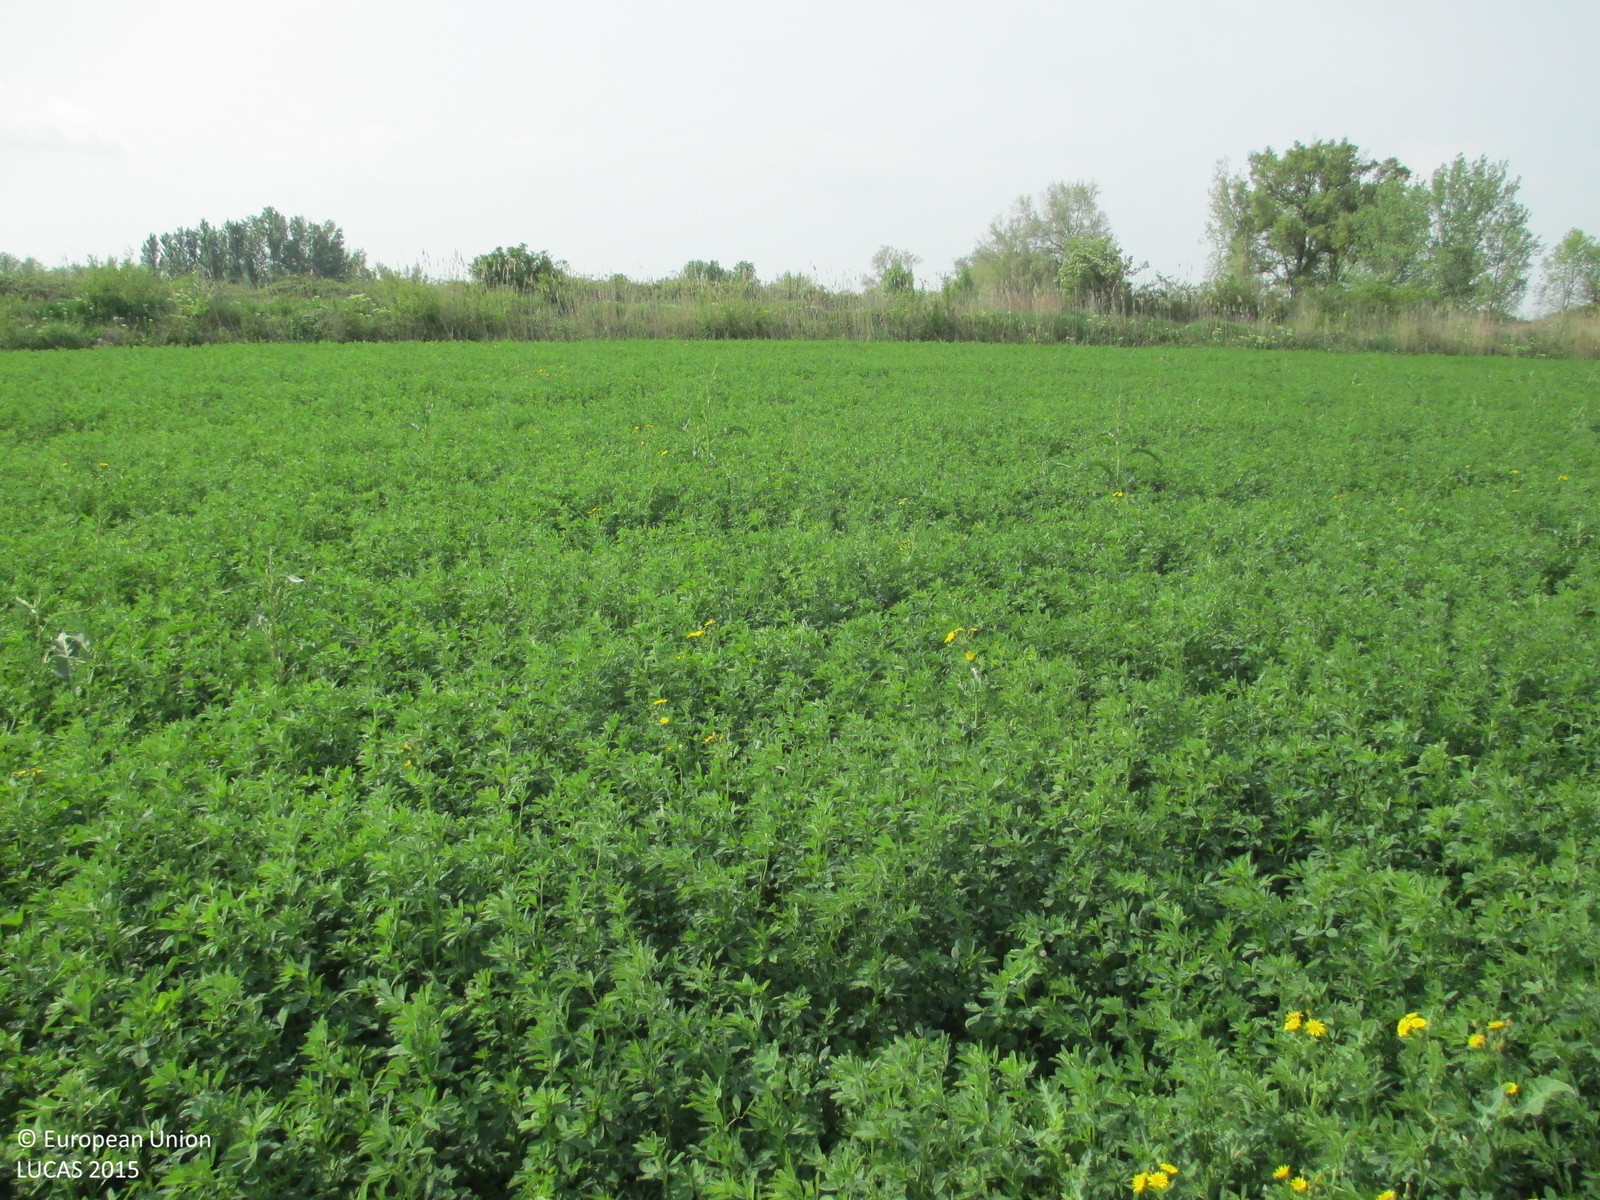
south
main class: Cropland
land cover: Lucerne
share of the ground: > 75 %
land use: Agriculture (excluding fallow land and kitchen gardens)
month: April
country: ES
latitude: 42.0827
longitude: -0.3817
